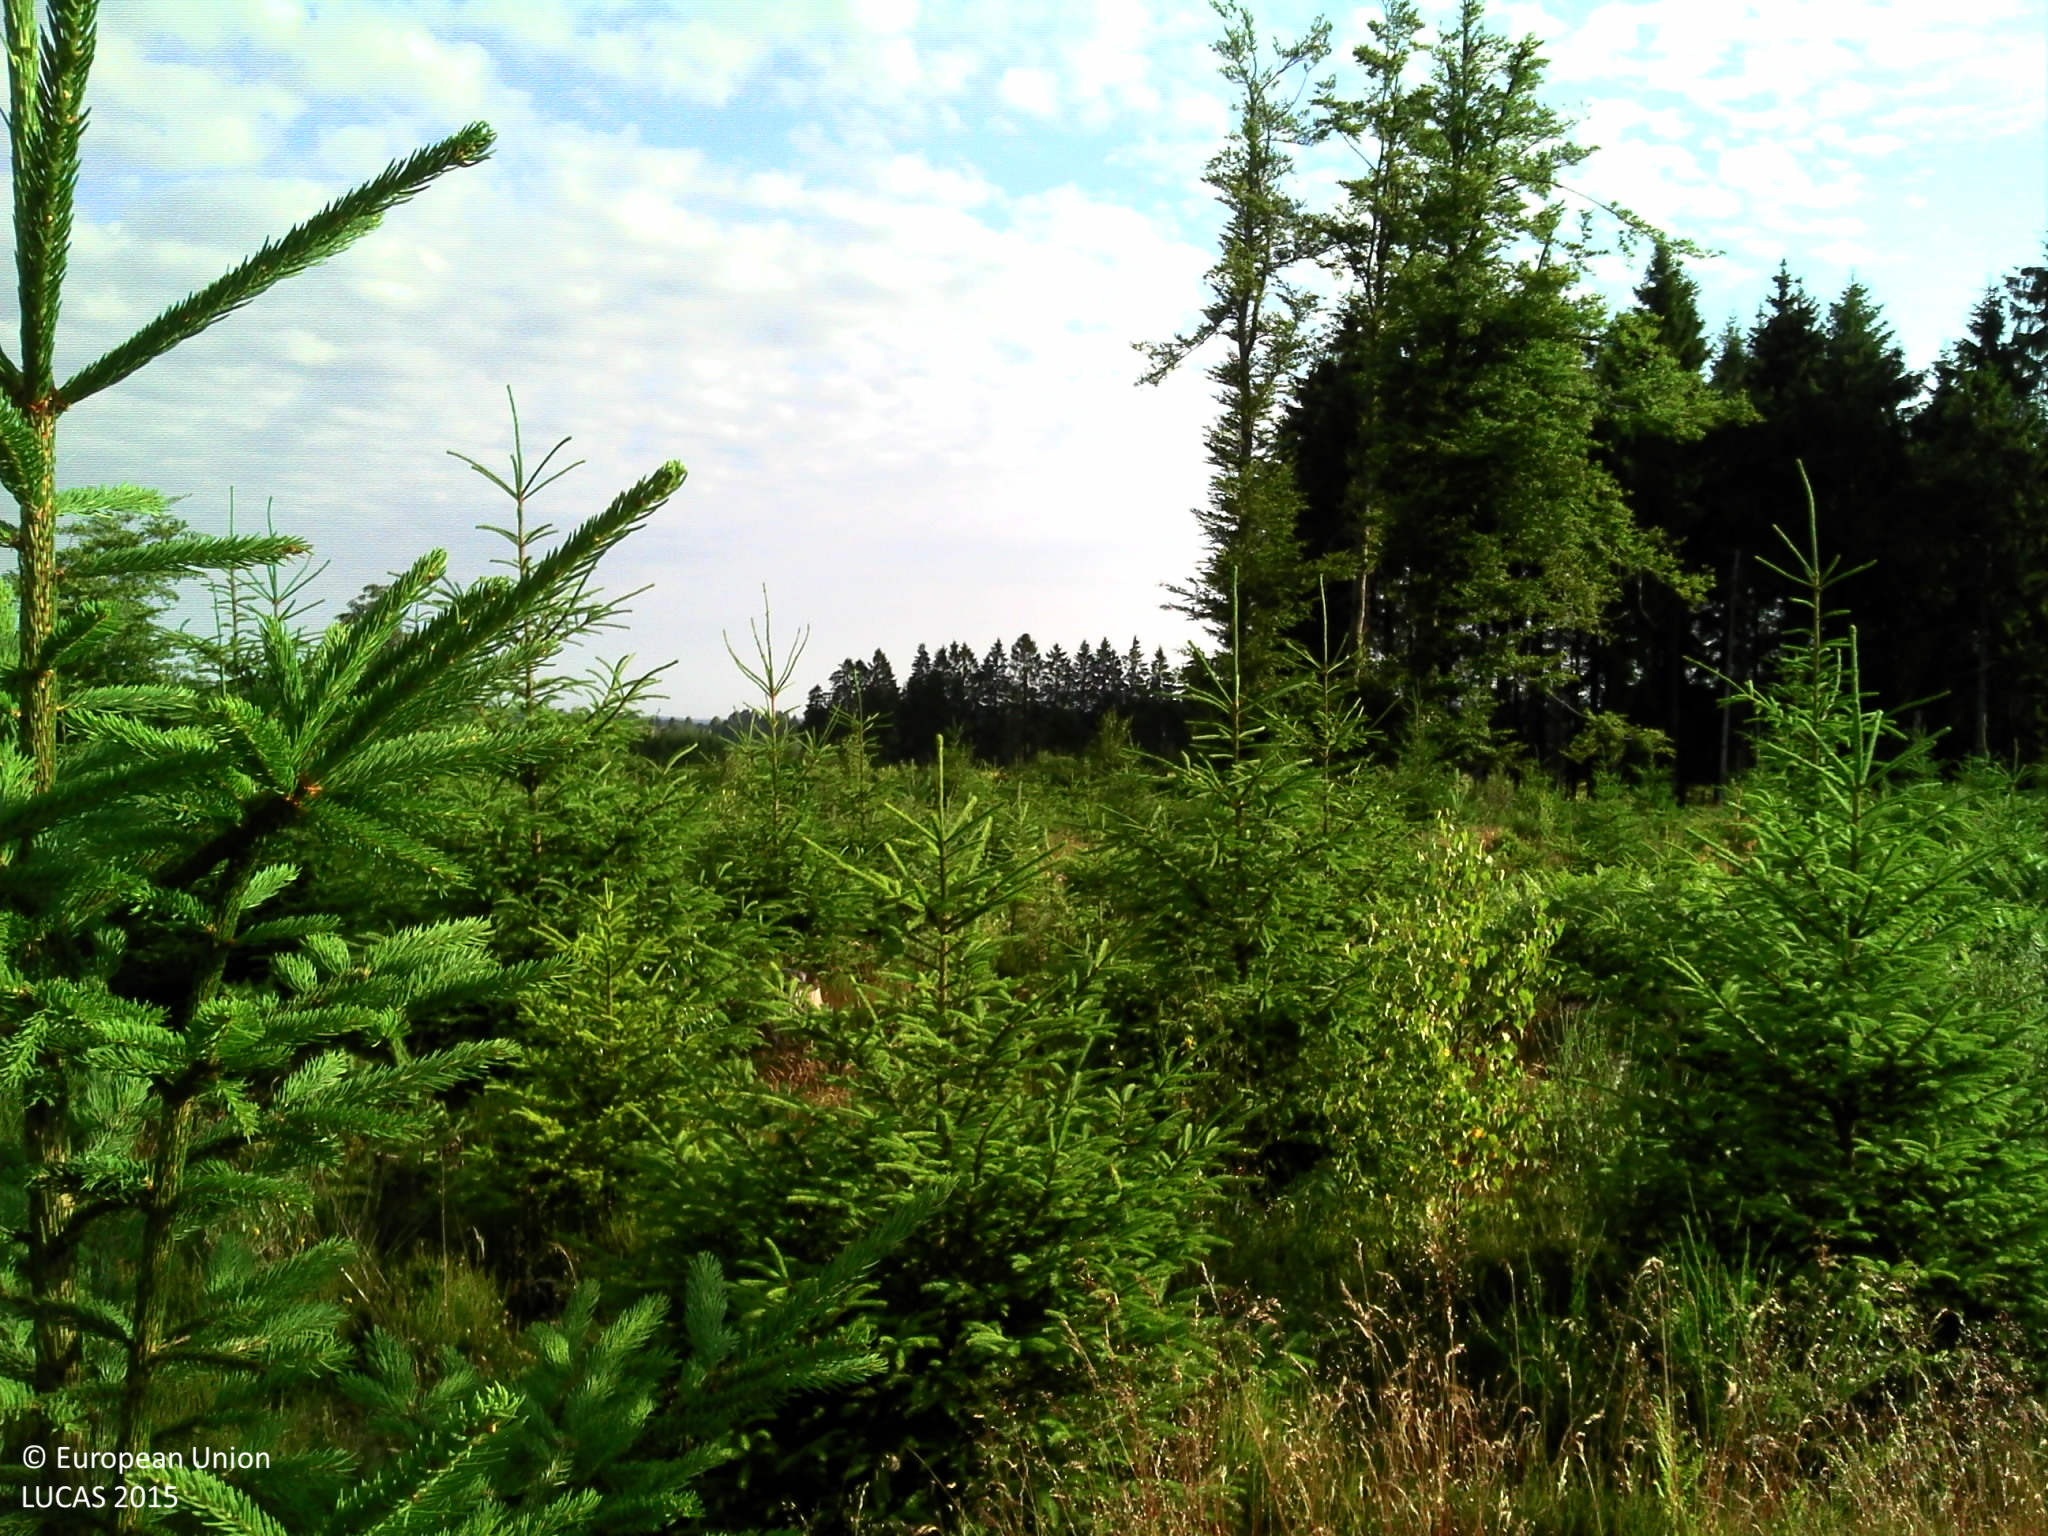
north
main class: Cropland
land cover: Nurseries
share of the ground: > 75 %
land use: Forestry
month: July
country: BE
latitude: 50.2322
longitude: 5.7790
